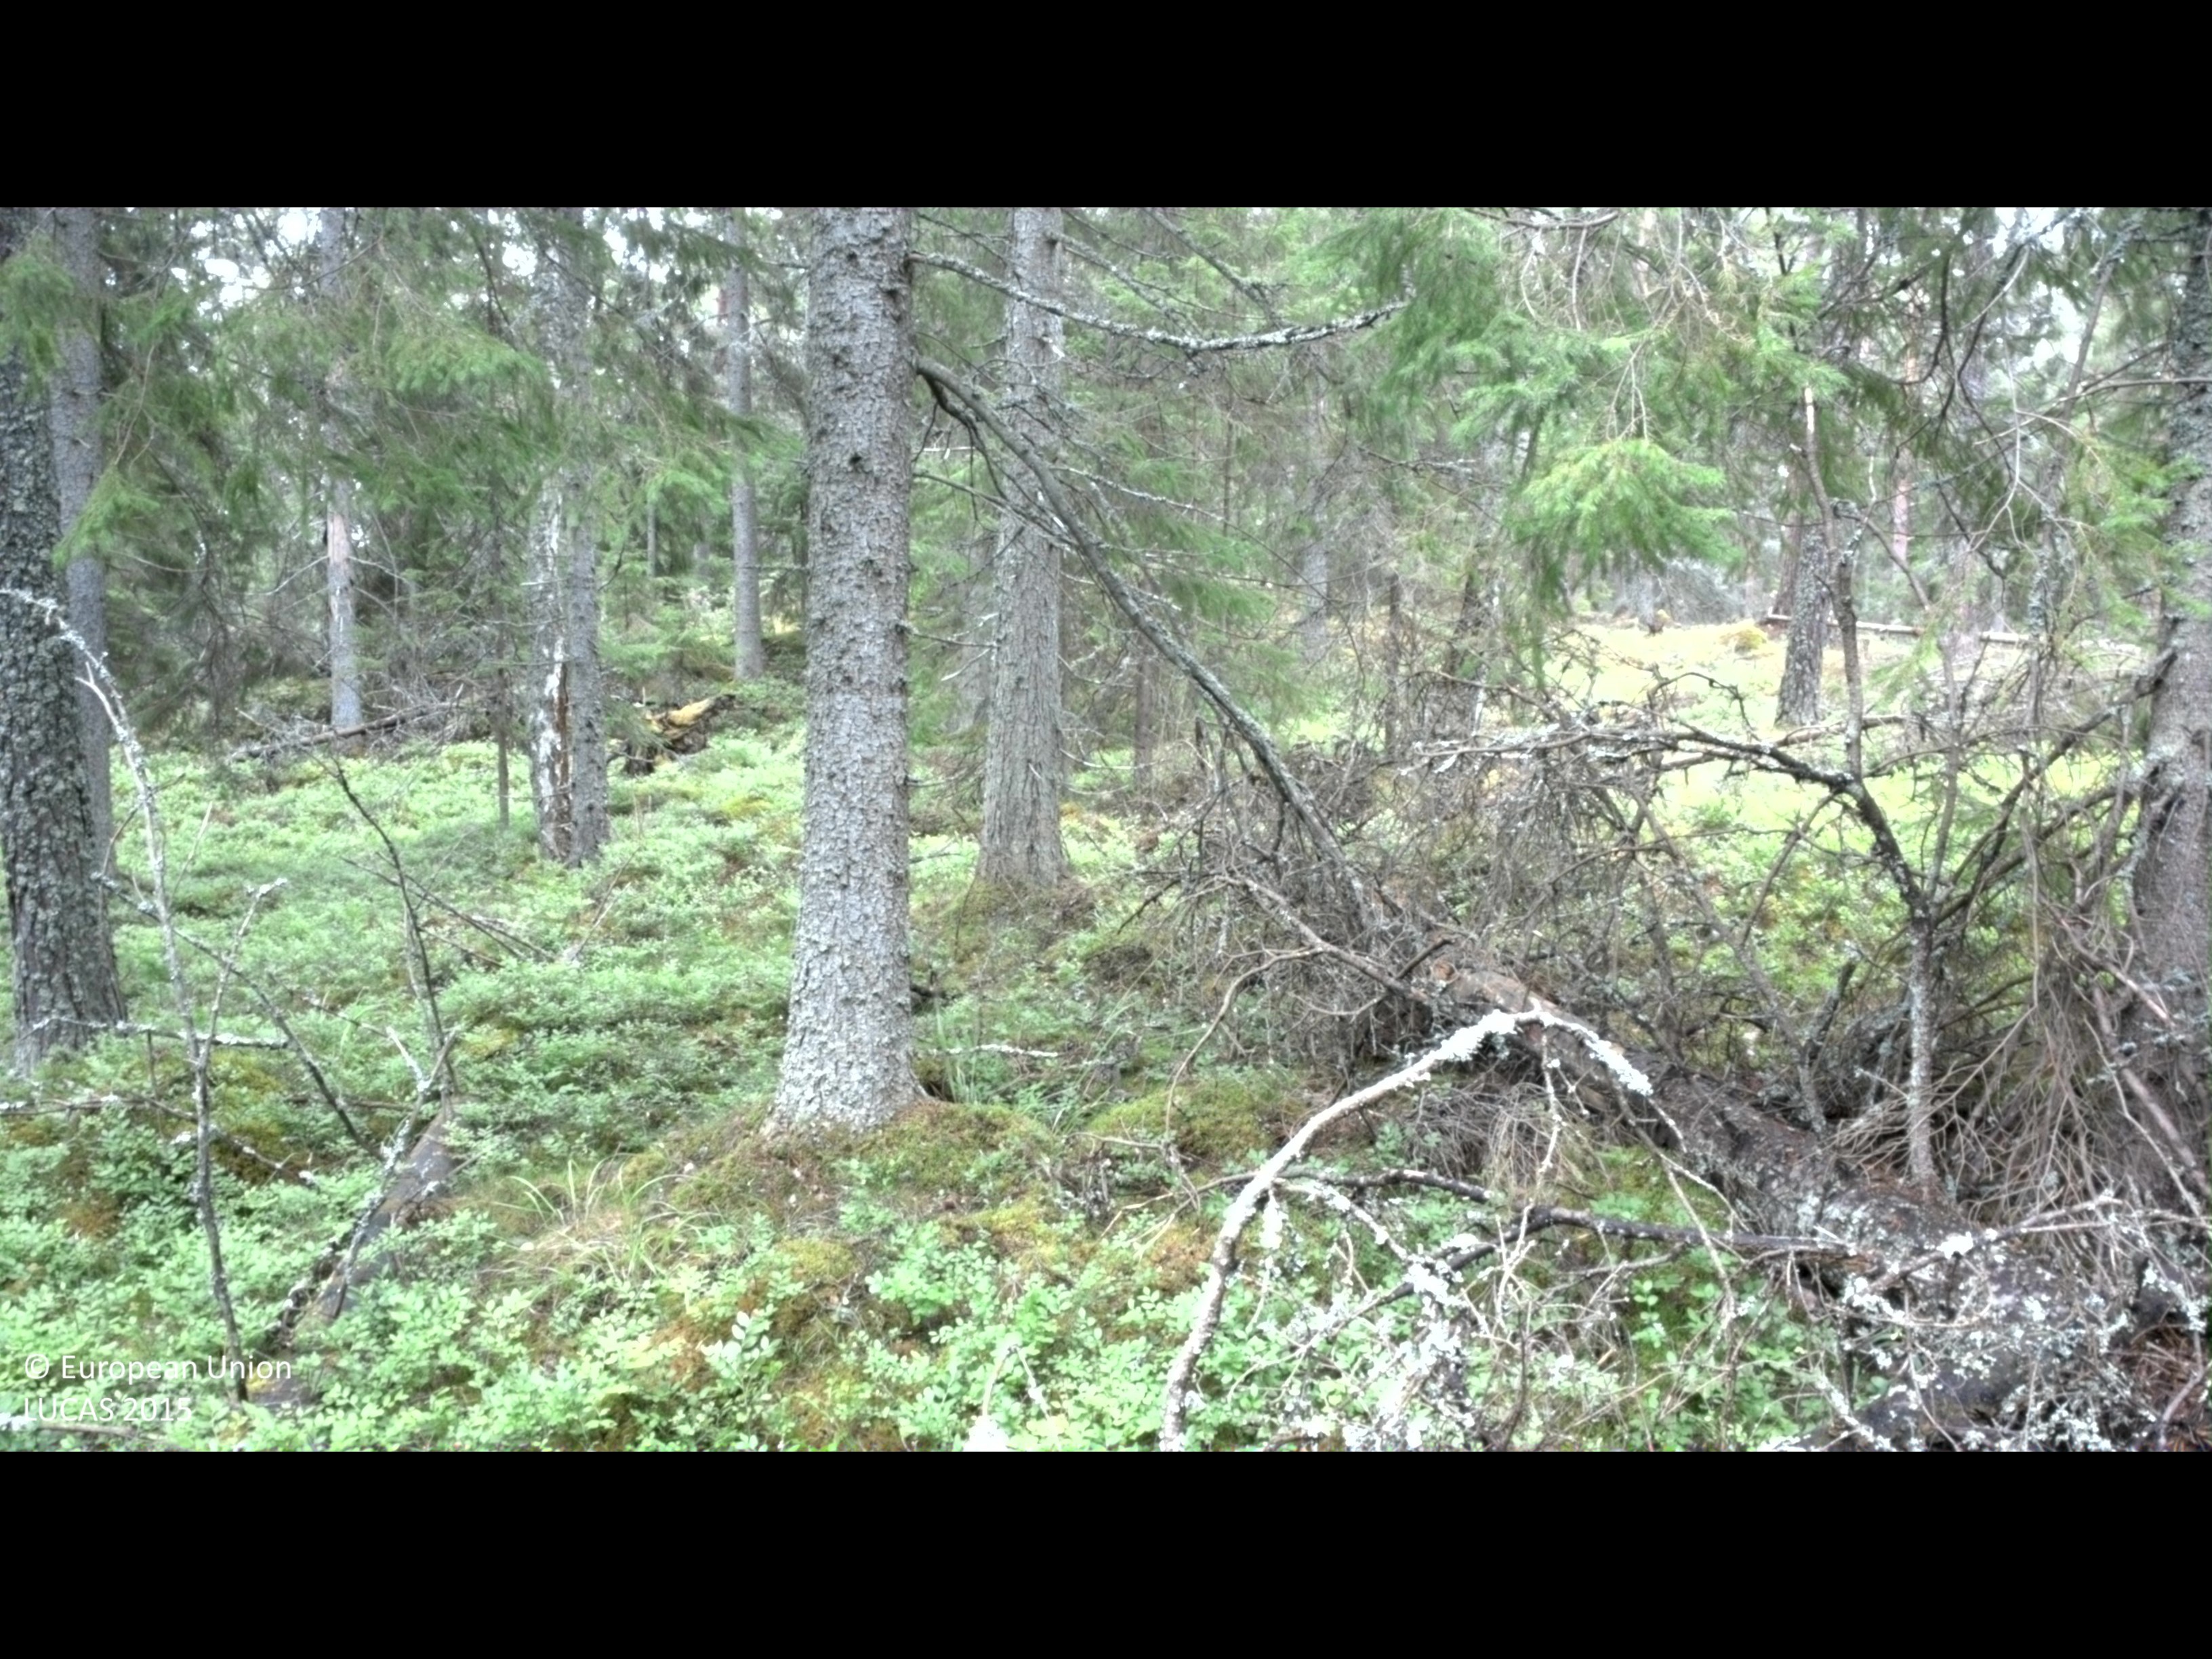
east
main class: Woodland
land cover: Other coniferous woodland
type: boreal forest
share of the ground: 50 - 75 %
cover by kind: coniferous forest trees 55 %, shrubs 35 %, broadleaved forest trees 10 %
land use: Amenities, museums, leisure
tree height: > 5 m
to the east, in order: Other coniferous woodland; Spruce dominated coniferous woodland; Spruce dominated mixed woodland; Broadleaved woodland; Spruce dominated mixed woodland; Broadleaved woodland; Spruce dominated mixed woodland; Spruce dominated coniferous woodland; Ditches and canals; Spruce dominated coniferous woodland
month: July
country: SE
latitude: 58.3115
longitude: 16.1915
